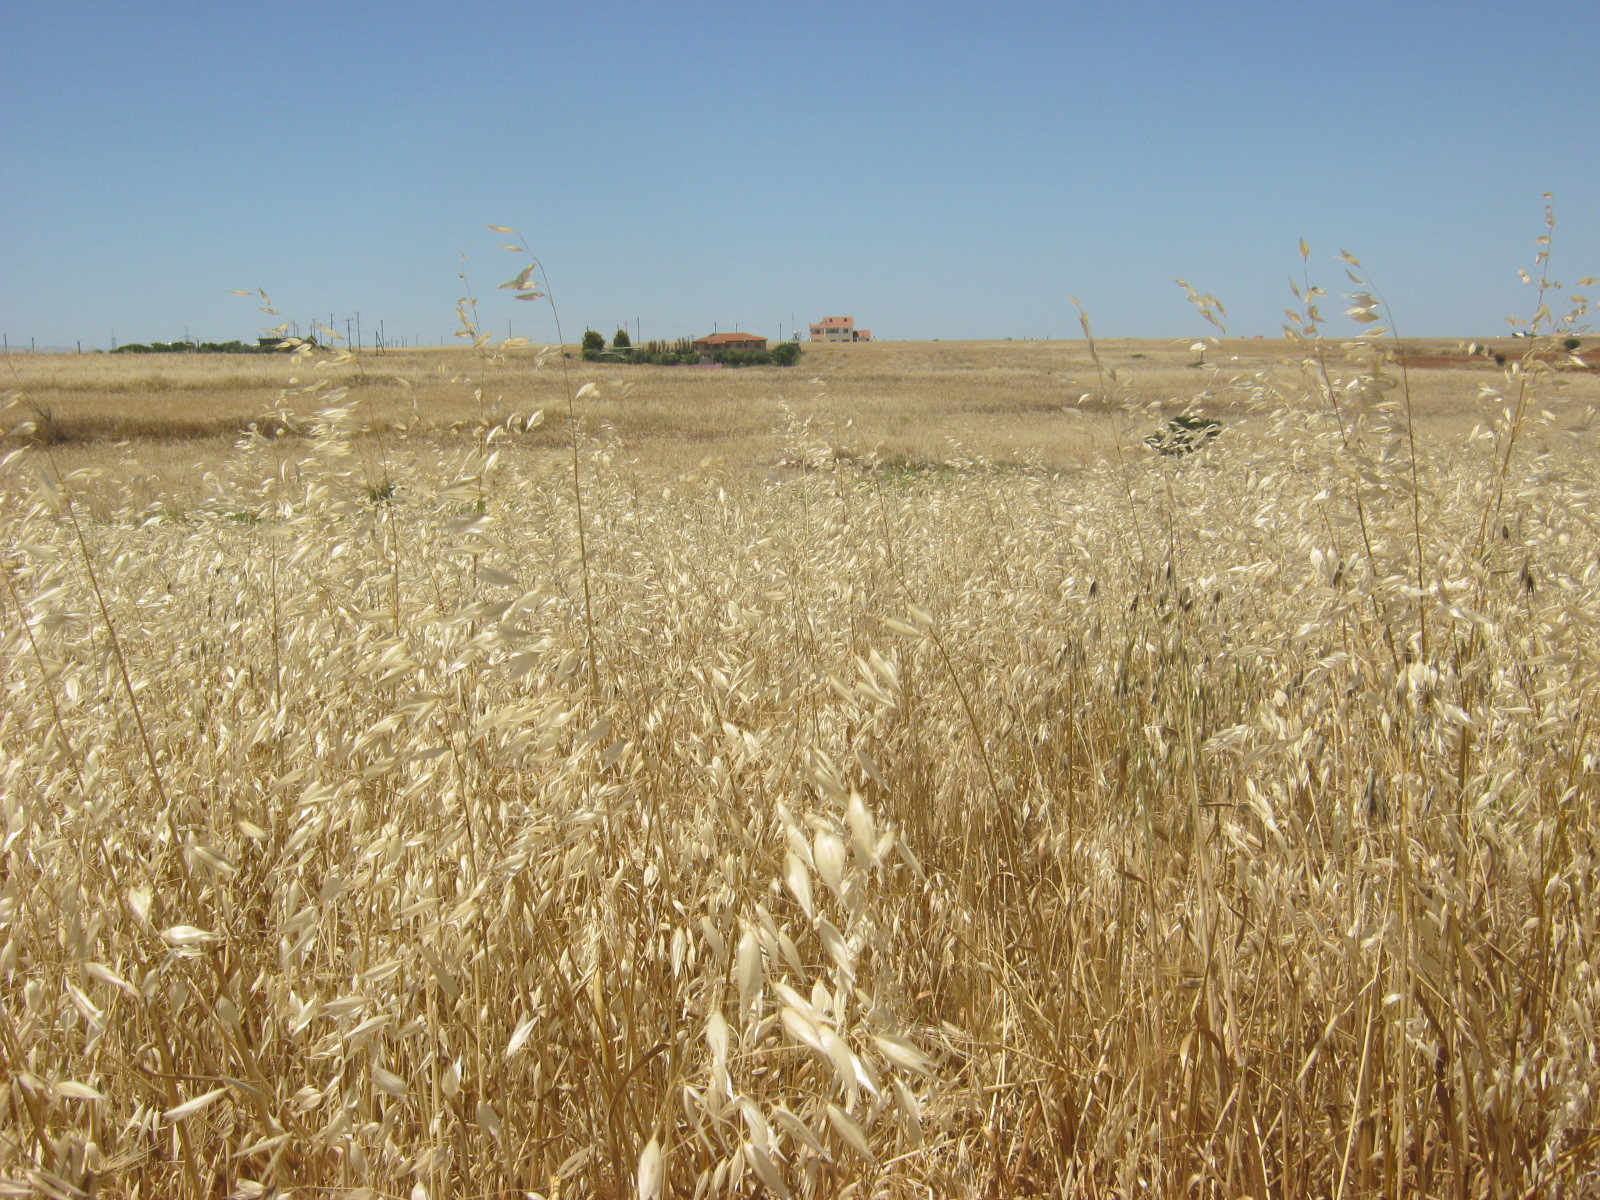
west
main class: Cropland
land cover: Barley
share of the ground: > 75 %
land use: Agriculture (excluding fallow land and kitchen gardens)
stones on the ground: 10 - 25 %
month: May
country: CY
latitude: 35.1082
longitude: 33.2374
